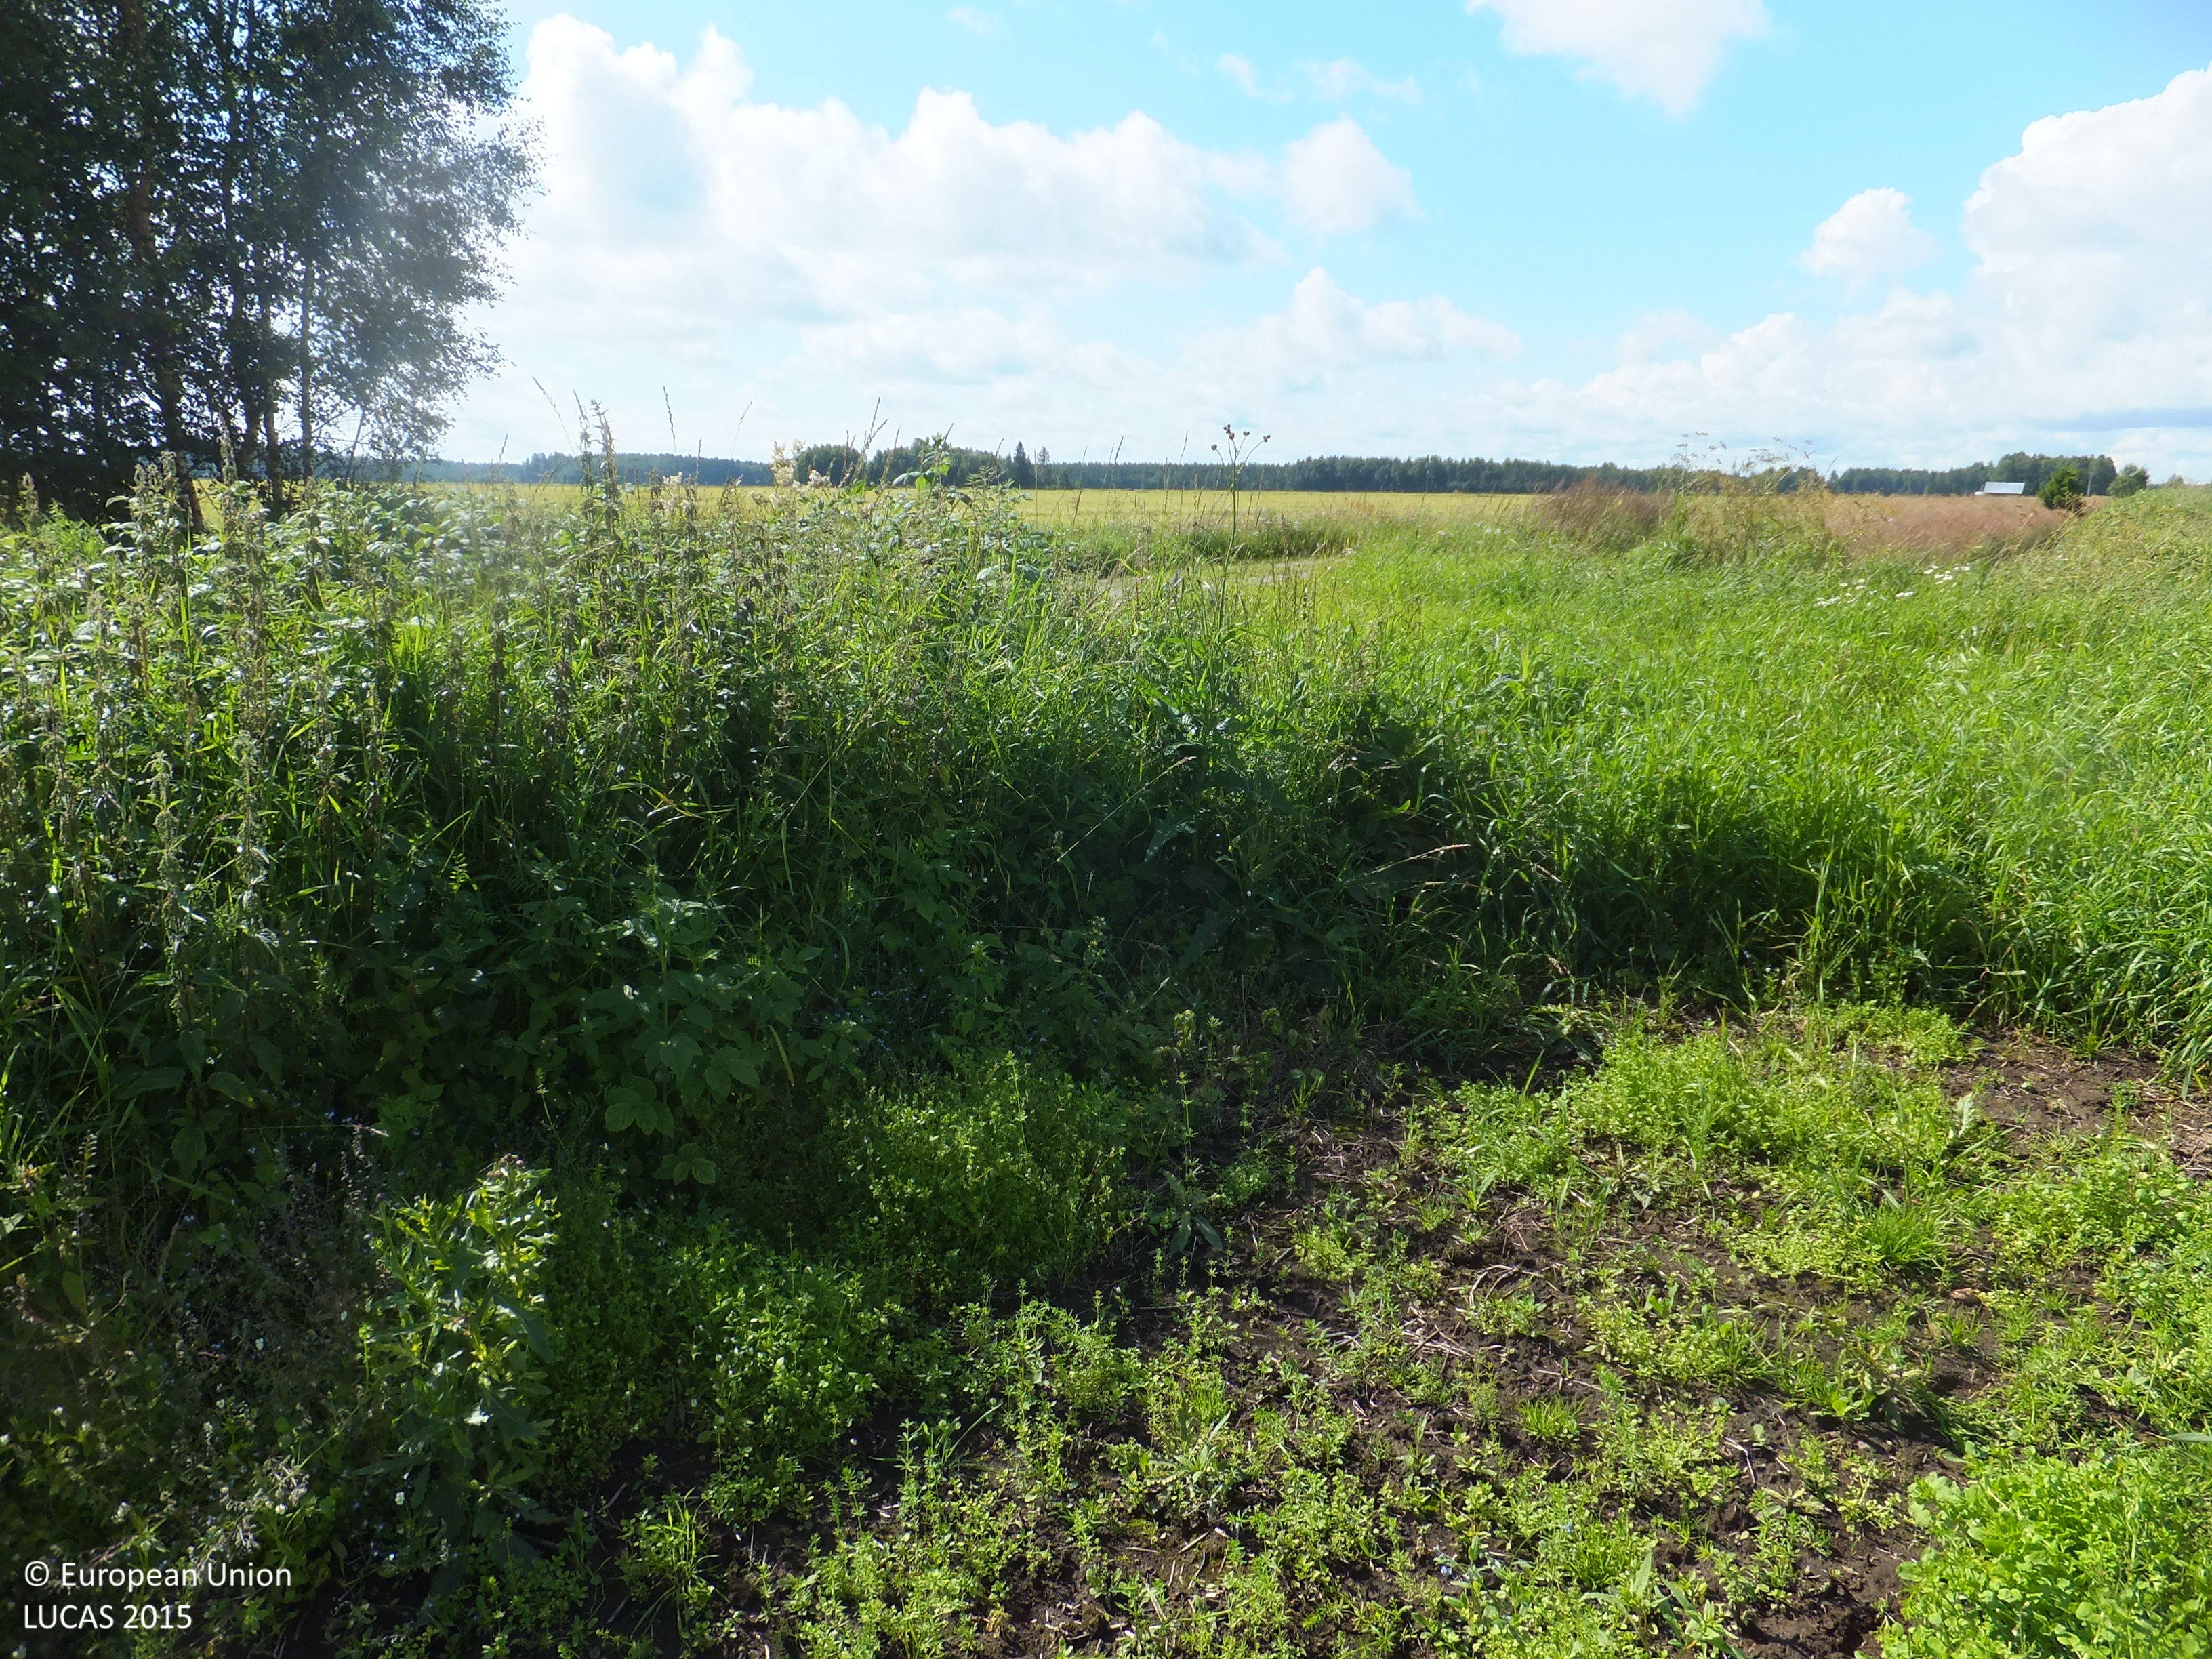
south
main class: Cropland
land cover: Barley
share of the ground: > 75 %
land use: Agriculture (excluding fallow land and kitchen gardens)
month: July
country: FI
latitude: 63.0639
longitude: 22.2163
